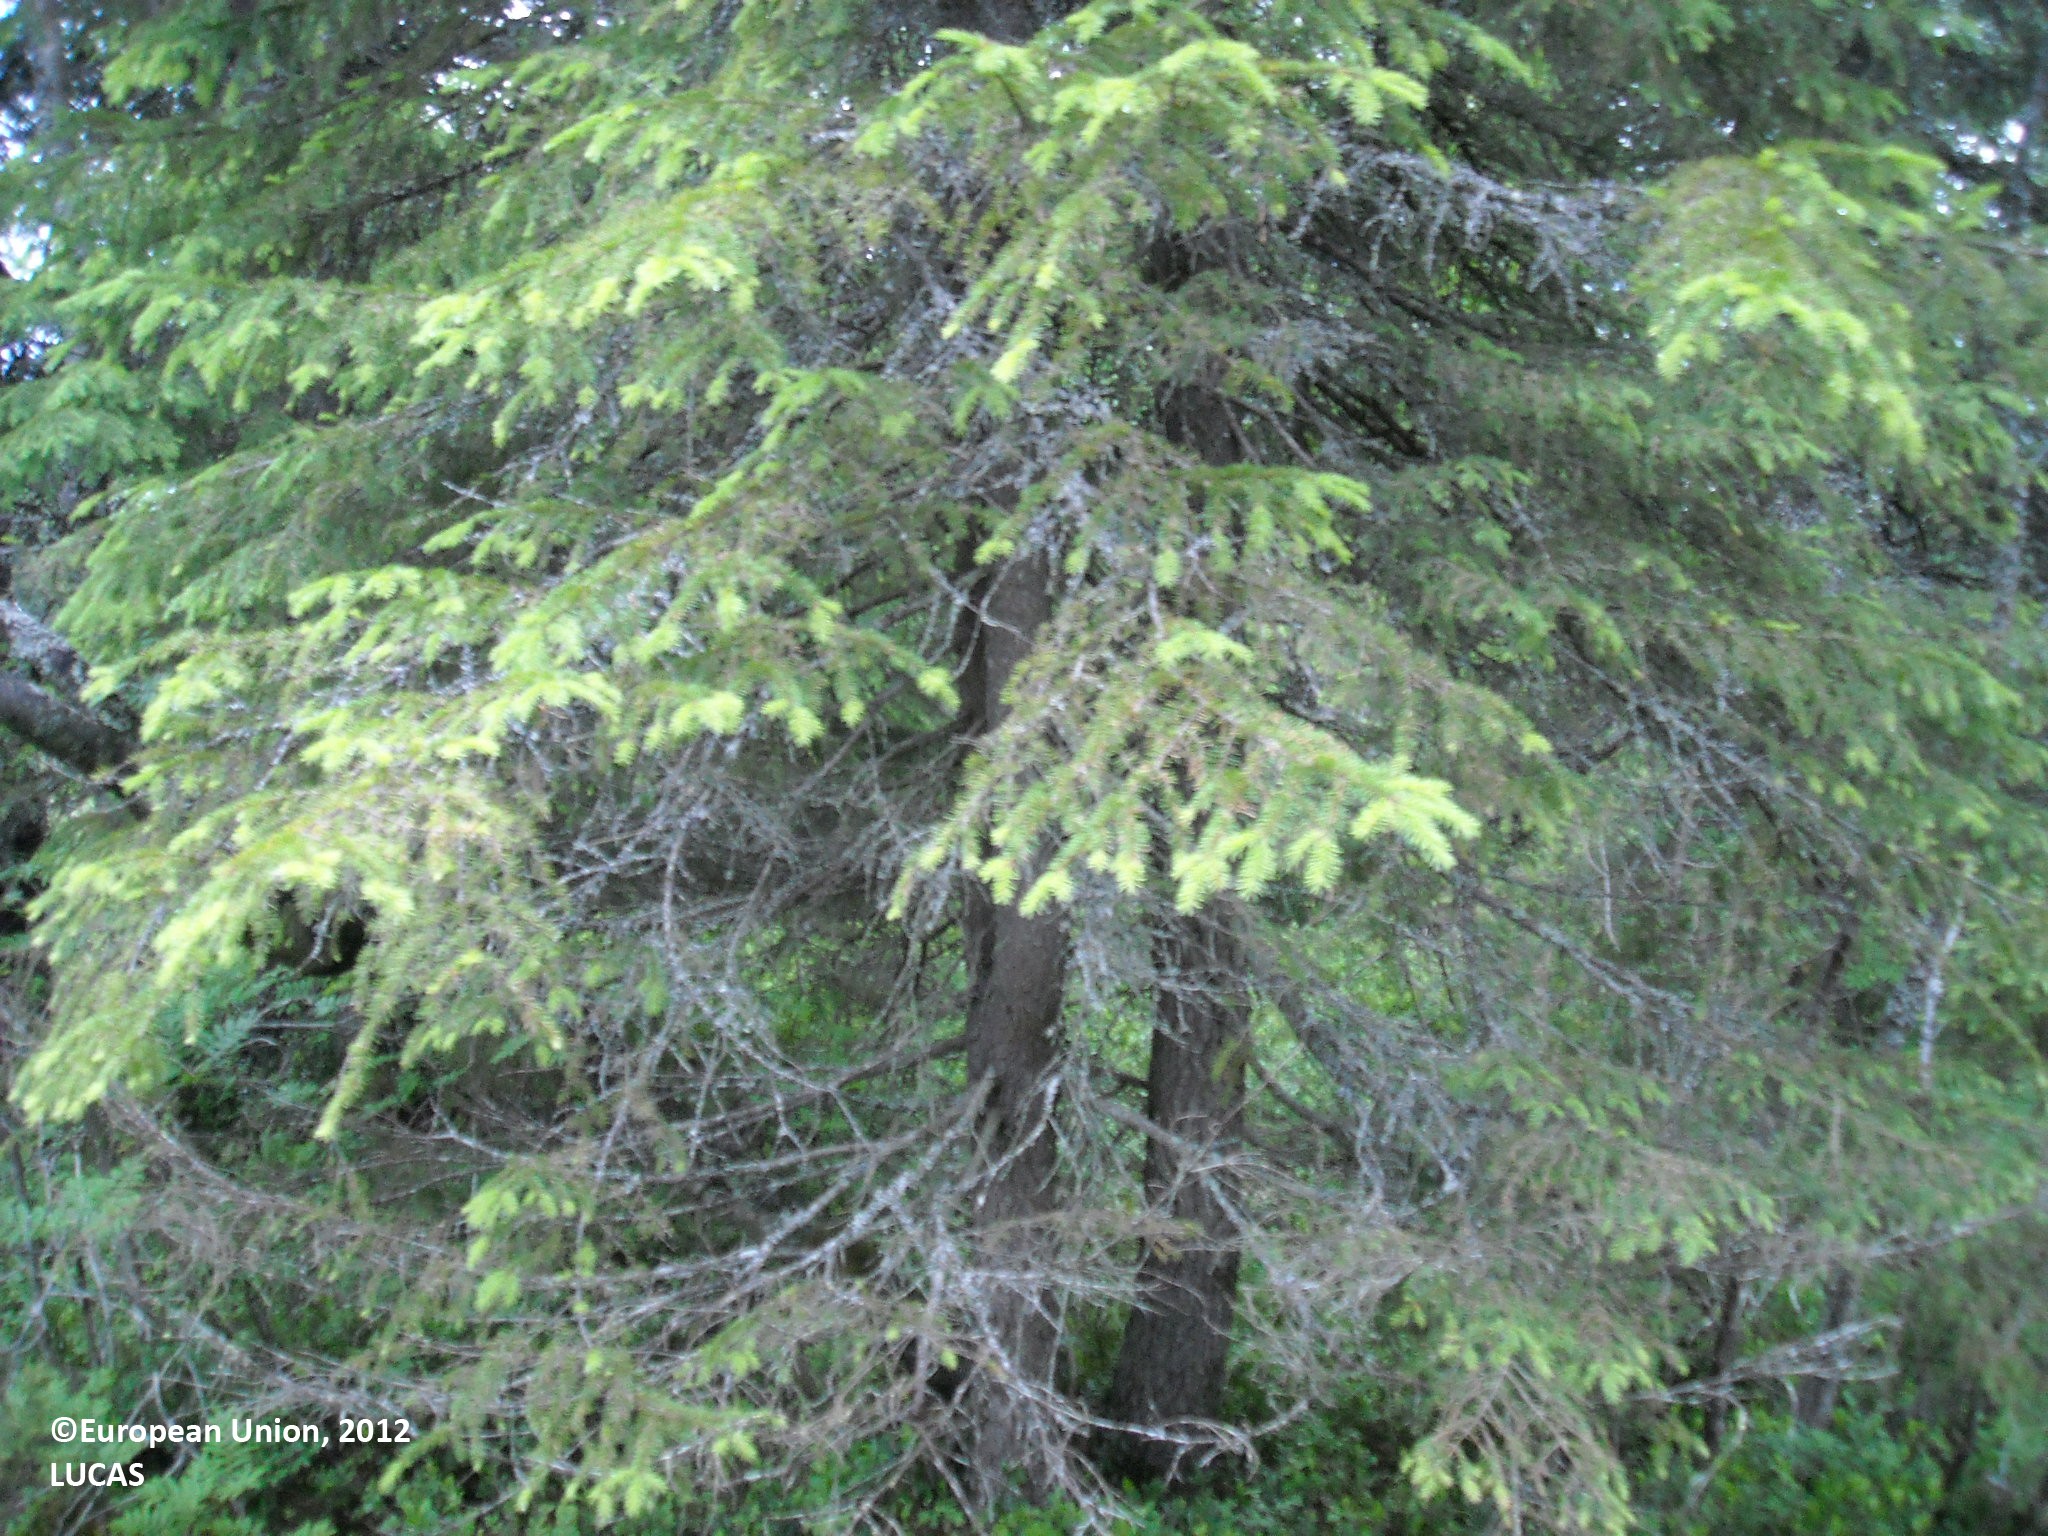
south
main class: Woodland
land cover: Spruce dominated mixed woodland
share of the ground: > 75 %
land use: Forestry
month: July
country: FI
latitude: 64.9894
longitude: 27.8917
